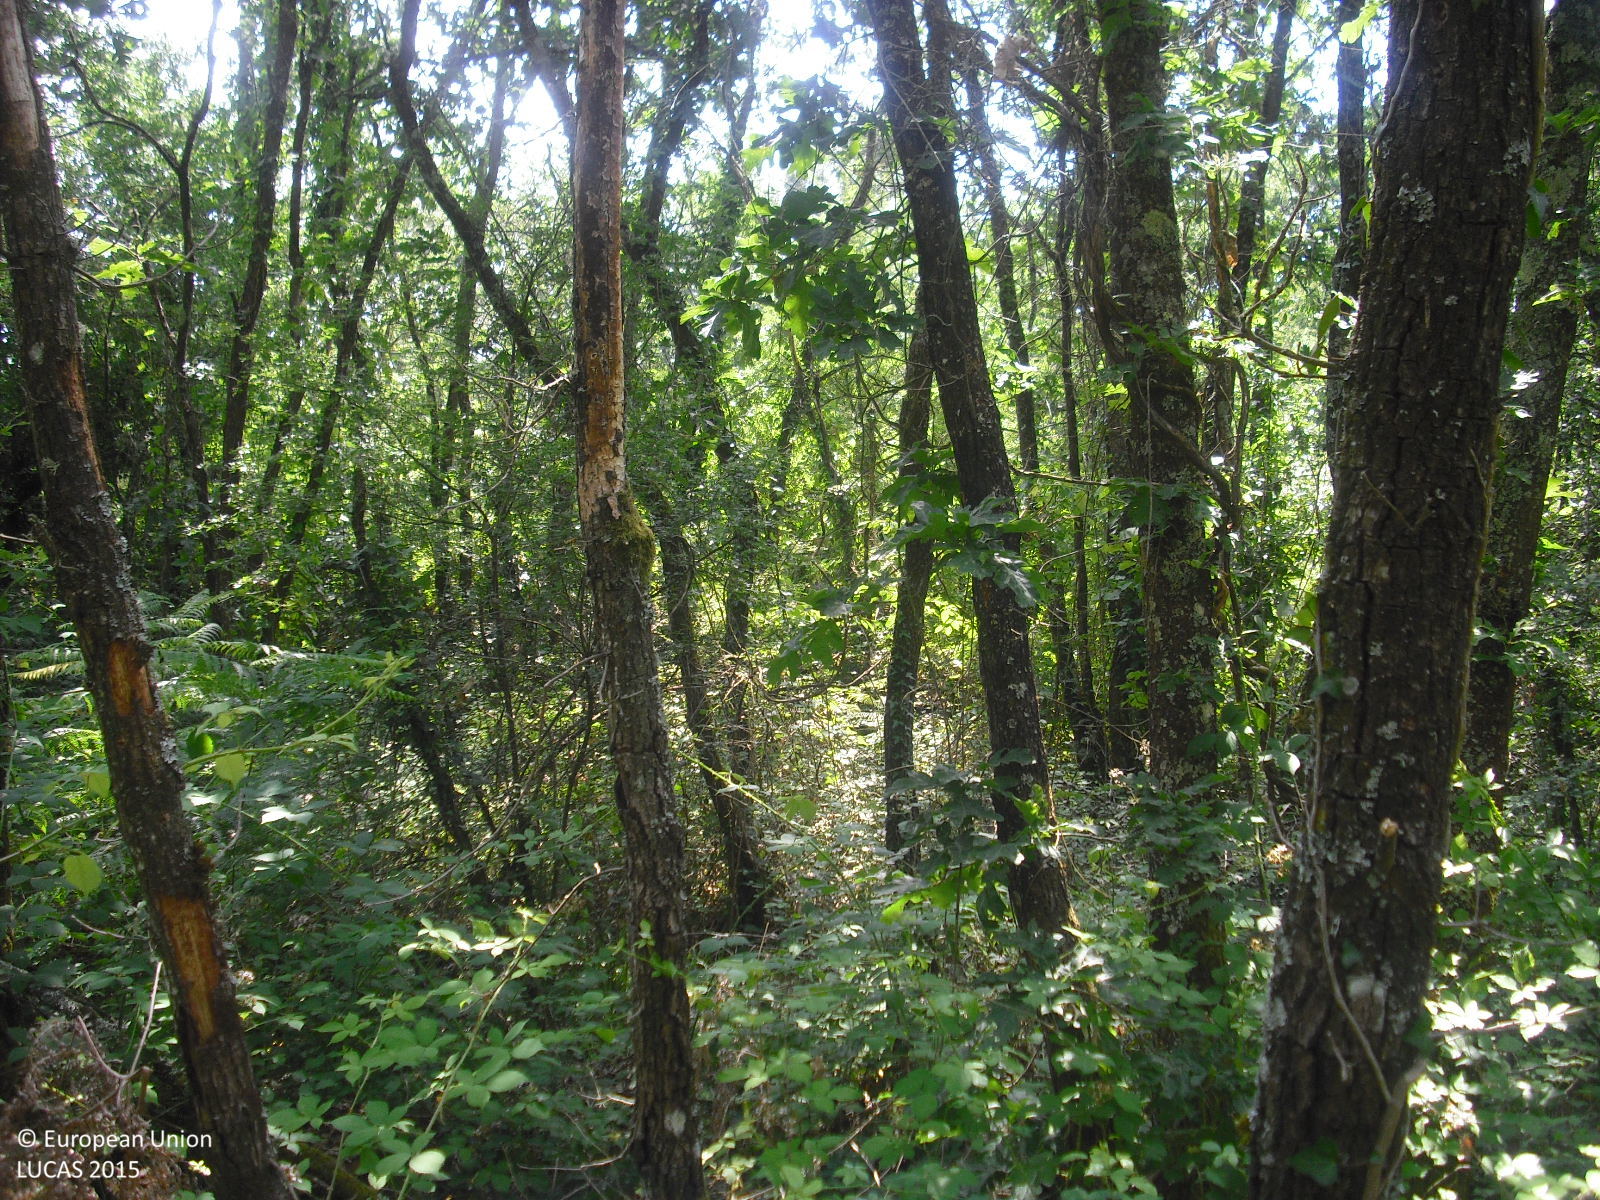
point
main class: Woodland
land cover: Broadleaved woodland
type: acidophilous oak and oak-birch forest
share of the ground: > 75 %
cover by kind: broadleaved forest trees 60 %, coniferous forest trees 20 %, shrubs 20 %
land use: Semi-natural and natural areas not in use
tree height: > 5 m
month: June
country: ES
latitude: 42.2730
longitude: -7.8383
